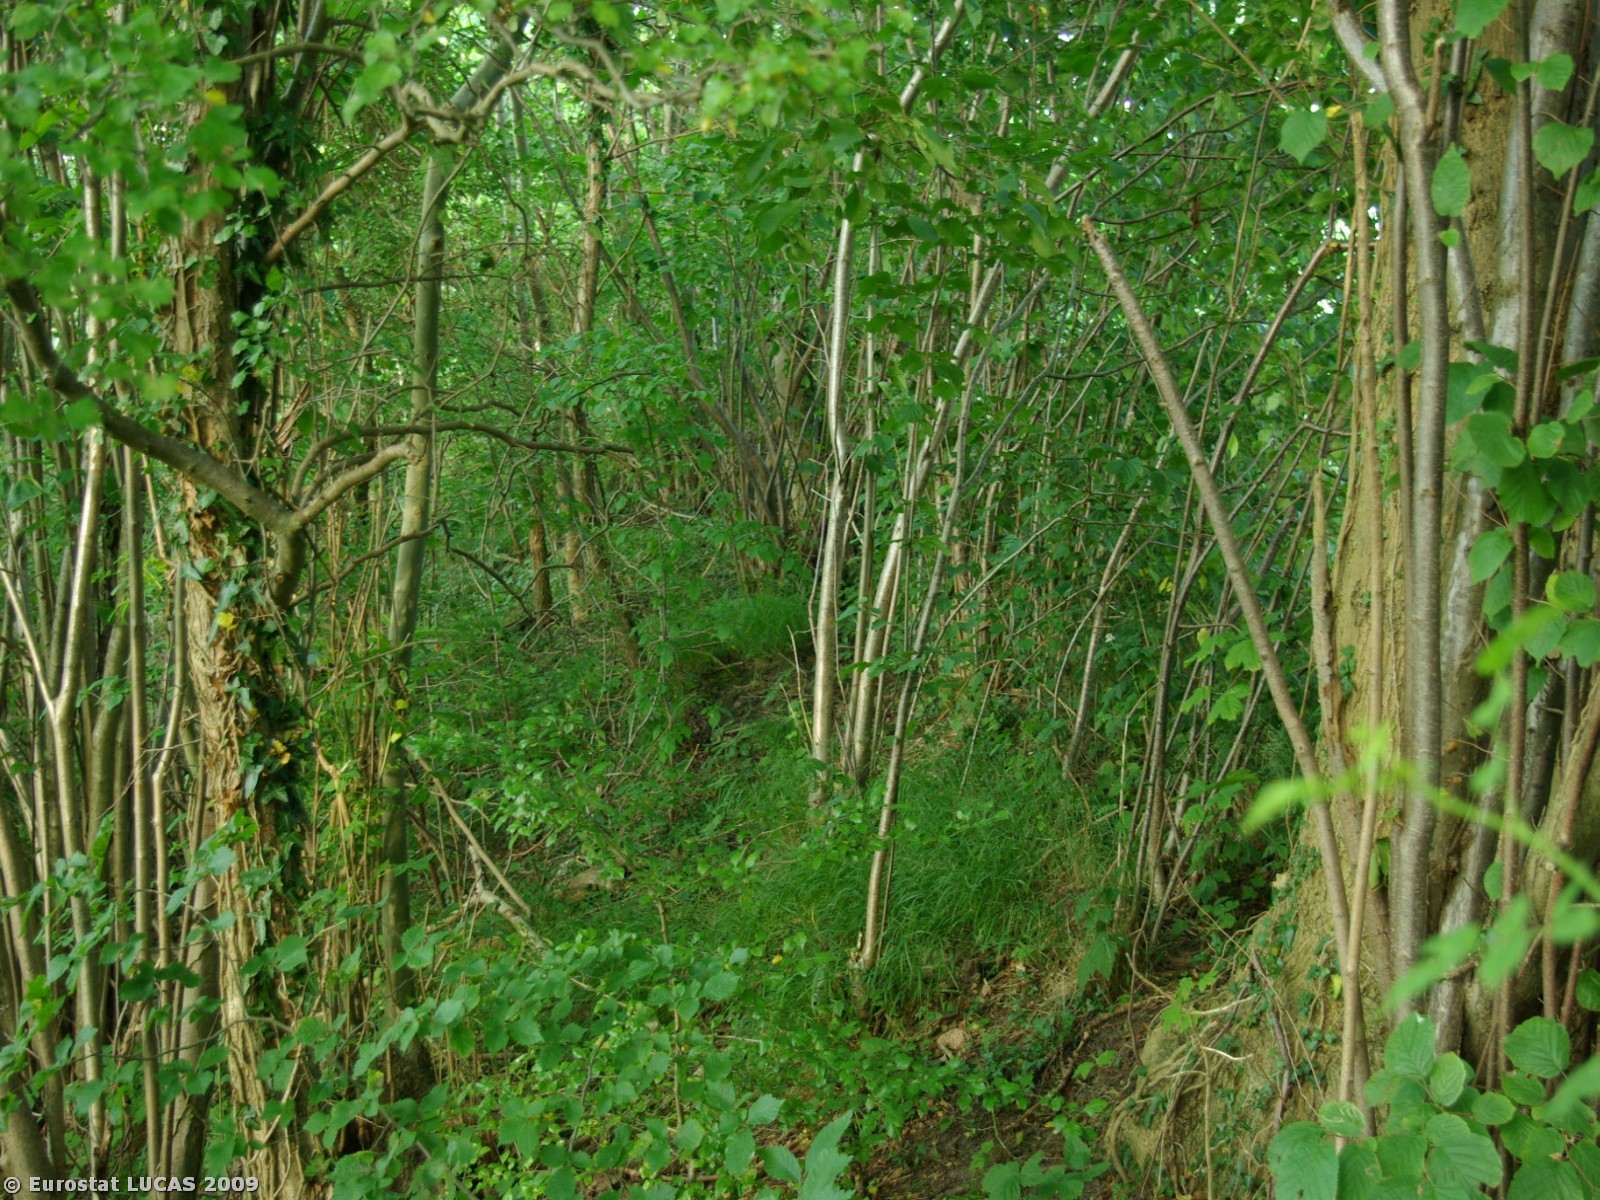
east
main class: Woodland
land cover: Broadleaved woodland
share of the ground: > 75 %
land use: Unused
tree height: > 5 m
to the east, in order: Broadleaved woodland; Fences; Spontaneously vegetated surfaces; Grass margins; Paved roads, cycling and walking lanes; Grass margins; Spontaneously vegetated surfaces; Ditches and canals; Broadleaved woodland; Grass margins; Temporary grasslands; Broadleaved woodland; Fences; Grassland without tree/shrub cover
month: July
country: DK
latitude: 54.9475
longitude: 9.8908
